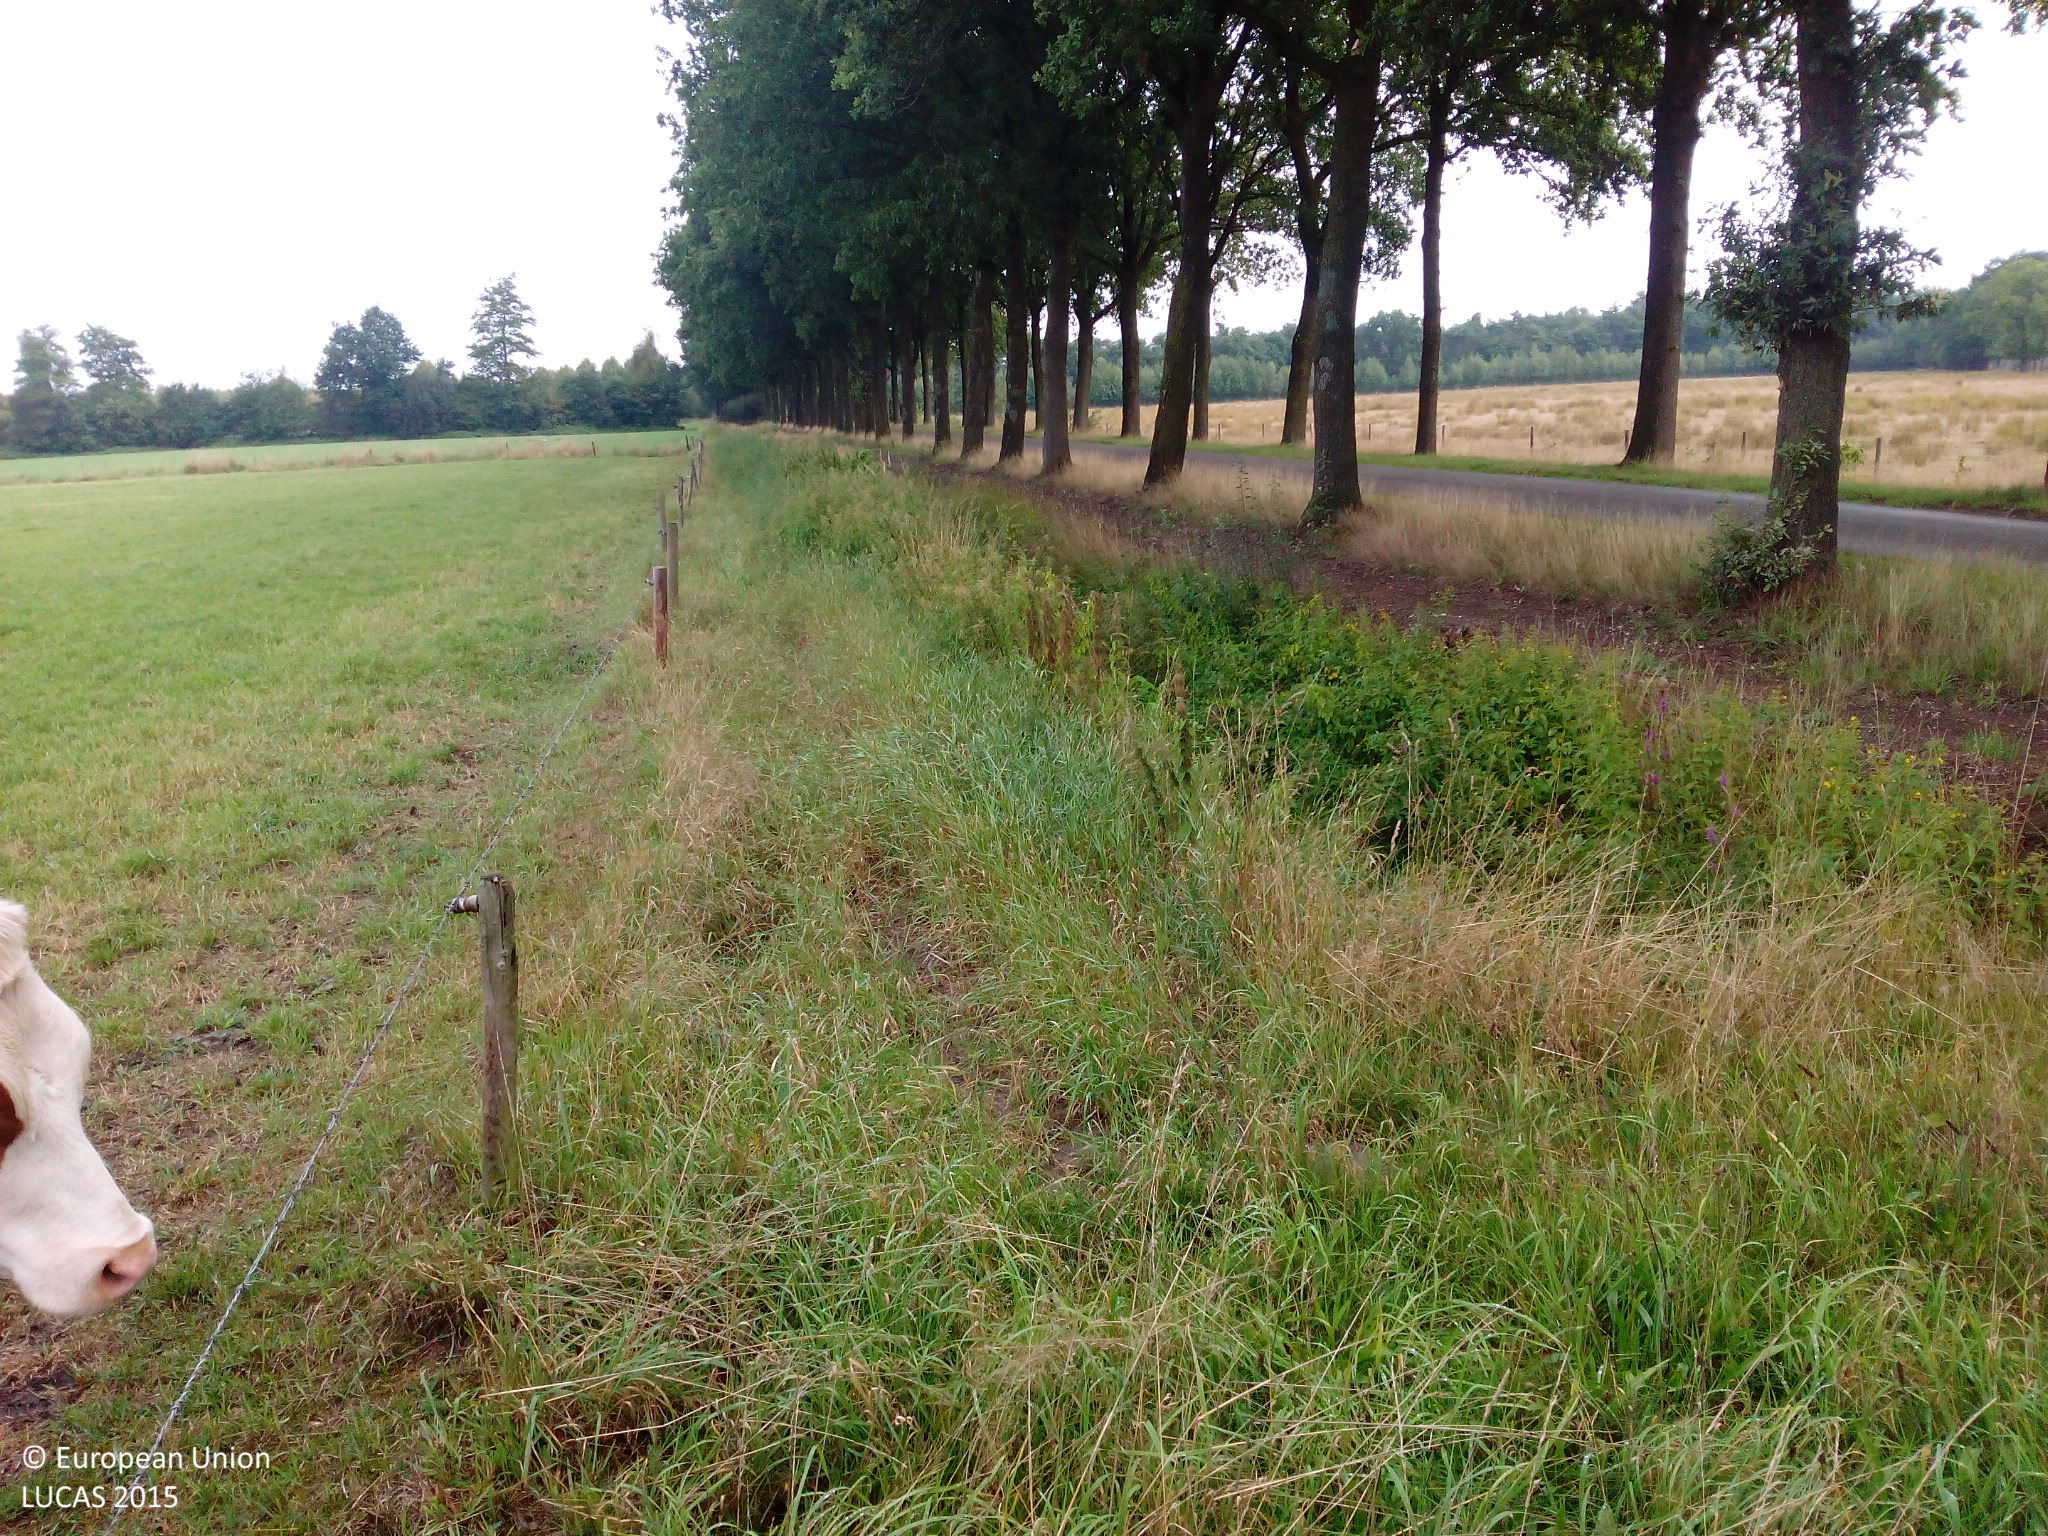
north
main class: Grassland
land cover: Grassland without tree/shrub cover
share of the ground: > 75 %
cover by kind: herbaceous plants 100 %
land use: Agriculture (excluding fallow land and kitchen gardens)
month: August
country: NL
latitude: 51.6644
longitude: 5.5598
